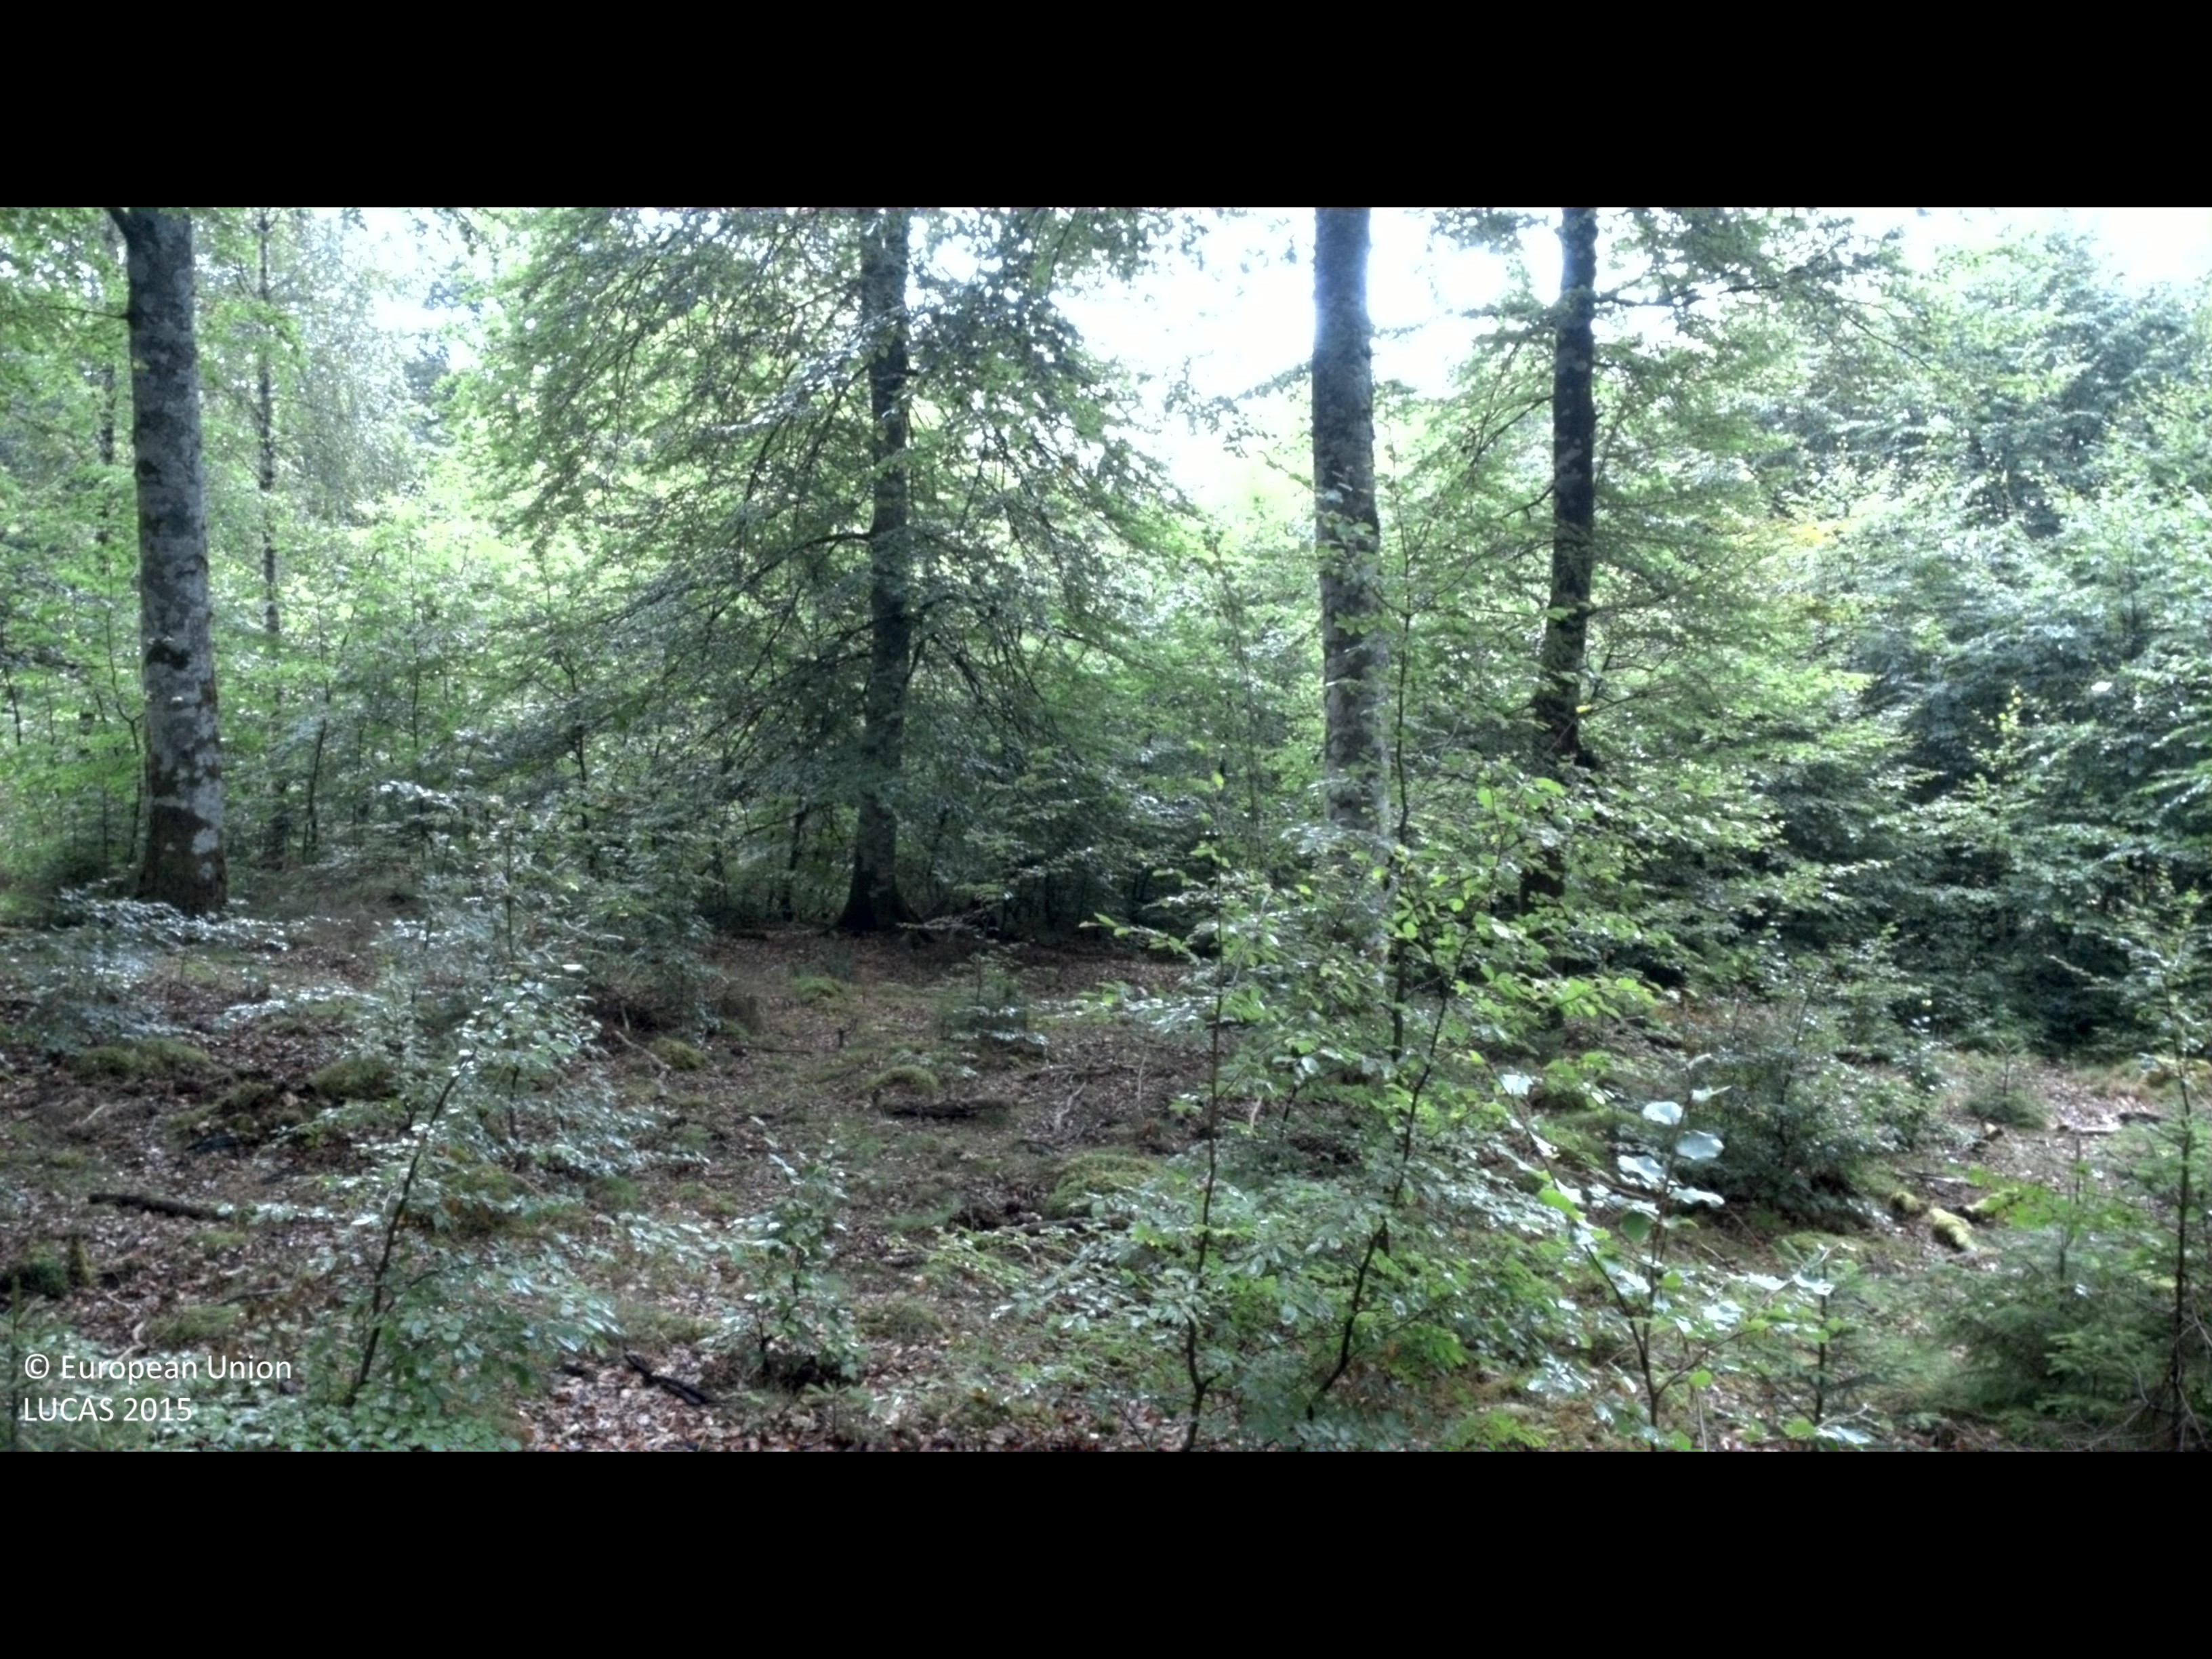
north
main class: Woodland
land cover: Broadleaved woodland
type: beech forest
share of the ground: > 75 %
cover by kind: broadleaved forest trees 75 %, lichens and mosses 5 %
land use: Forestry
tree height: > 5 m
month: August
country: SE
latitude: 57.1372
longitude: 13.8791
